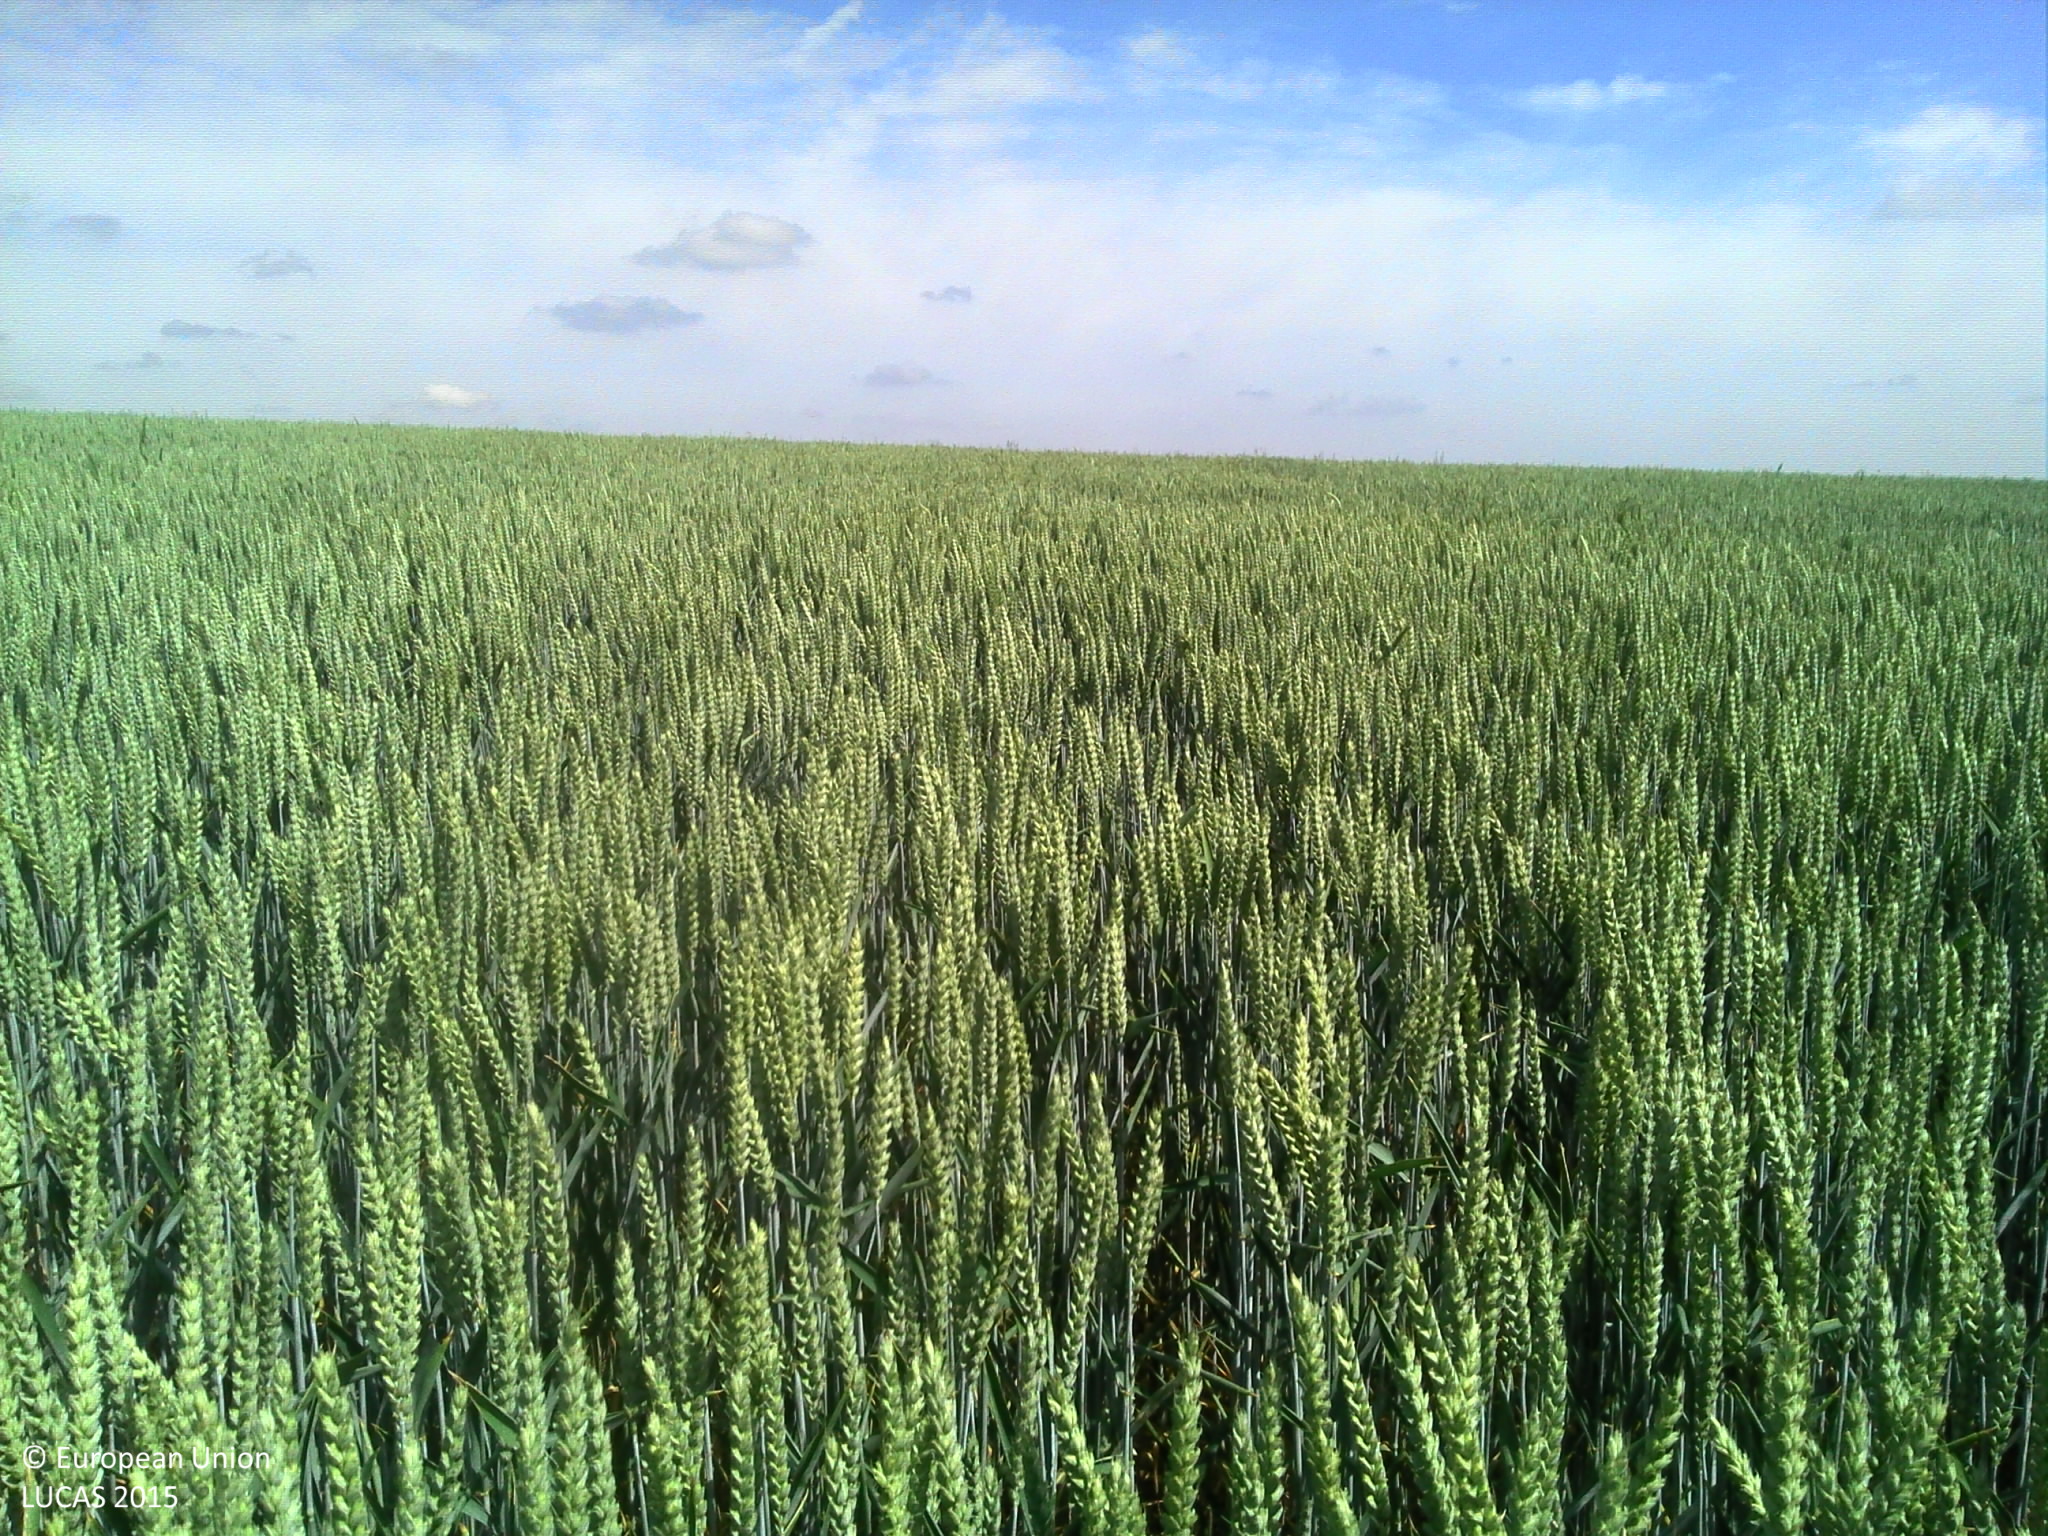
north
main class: Cropland
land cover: Common wheat
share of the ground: > 75 %
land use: Agriculture (excluding fallow land and kitchen gardens)
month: June
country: FR
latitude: 49.7062
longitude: 2.2907
